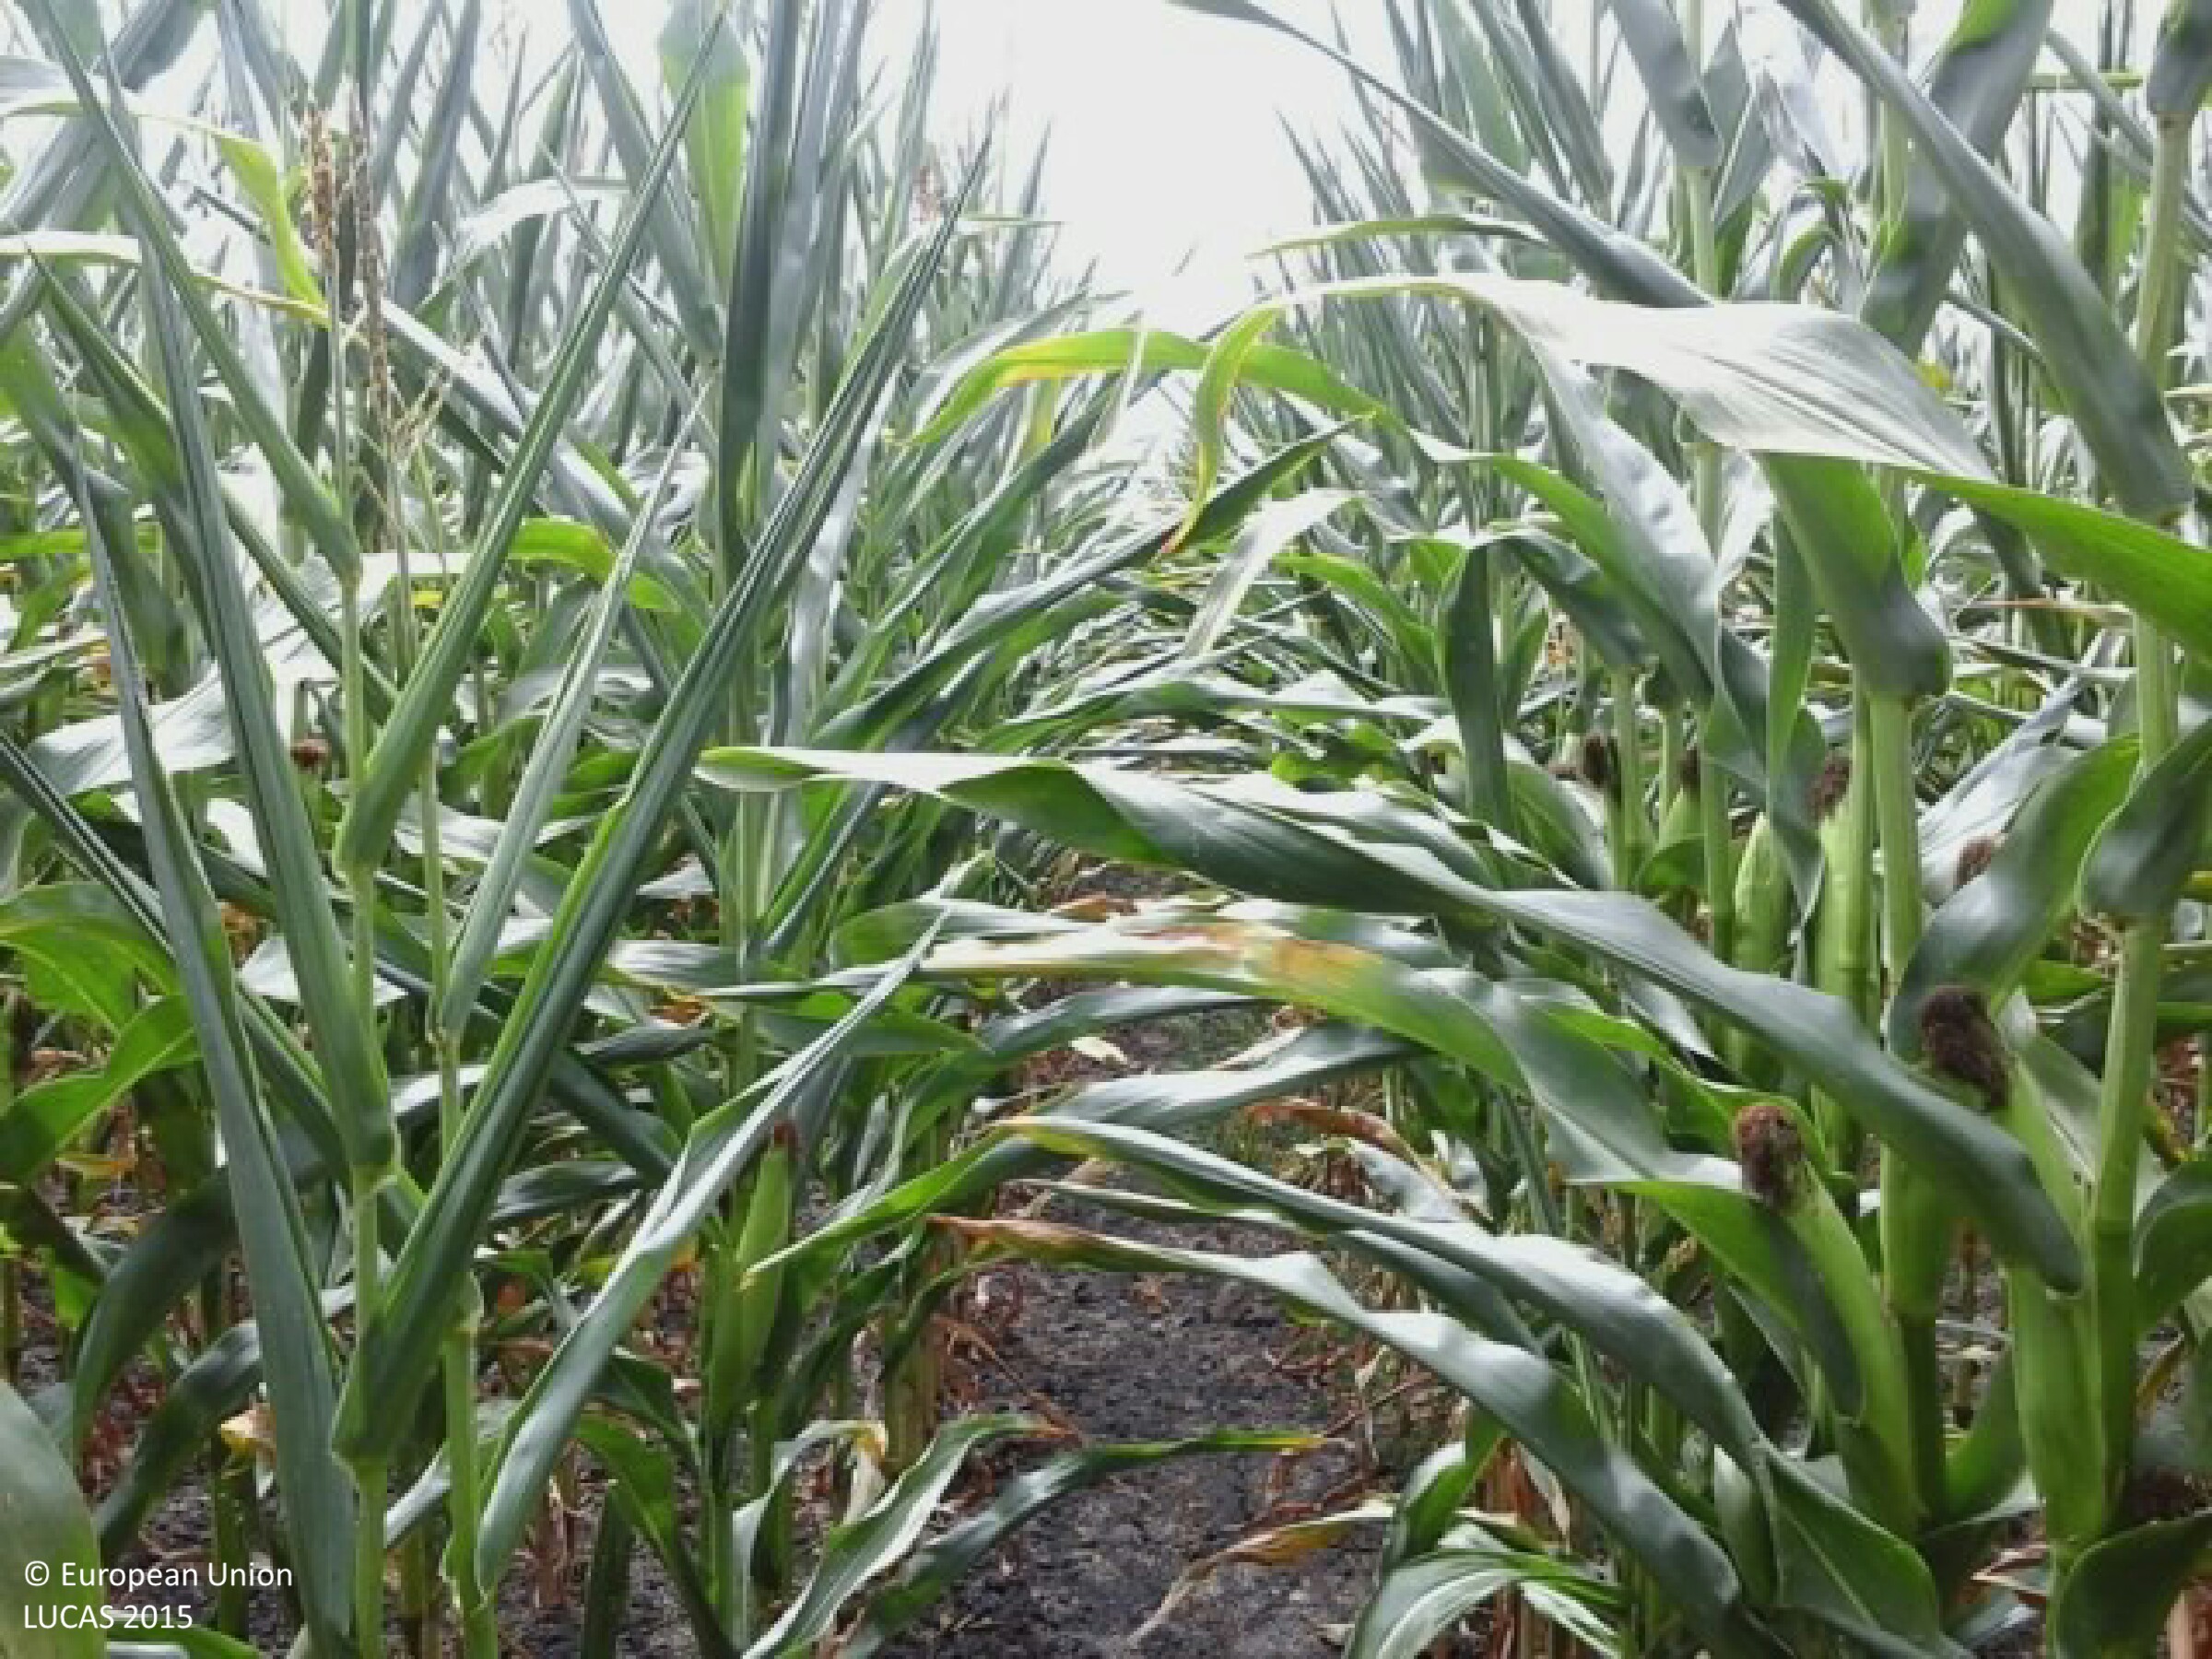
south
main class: Cropland
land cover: Maize
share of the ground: > 75 %
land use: Agriculture (excluding fallow land and kitchen gardens)
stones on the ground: < 10 %
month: July
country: HU
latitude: 46.2223
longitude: 18.8141
